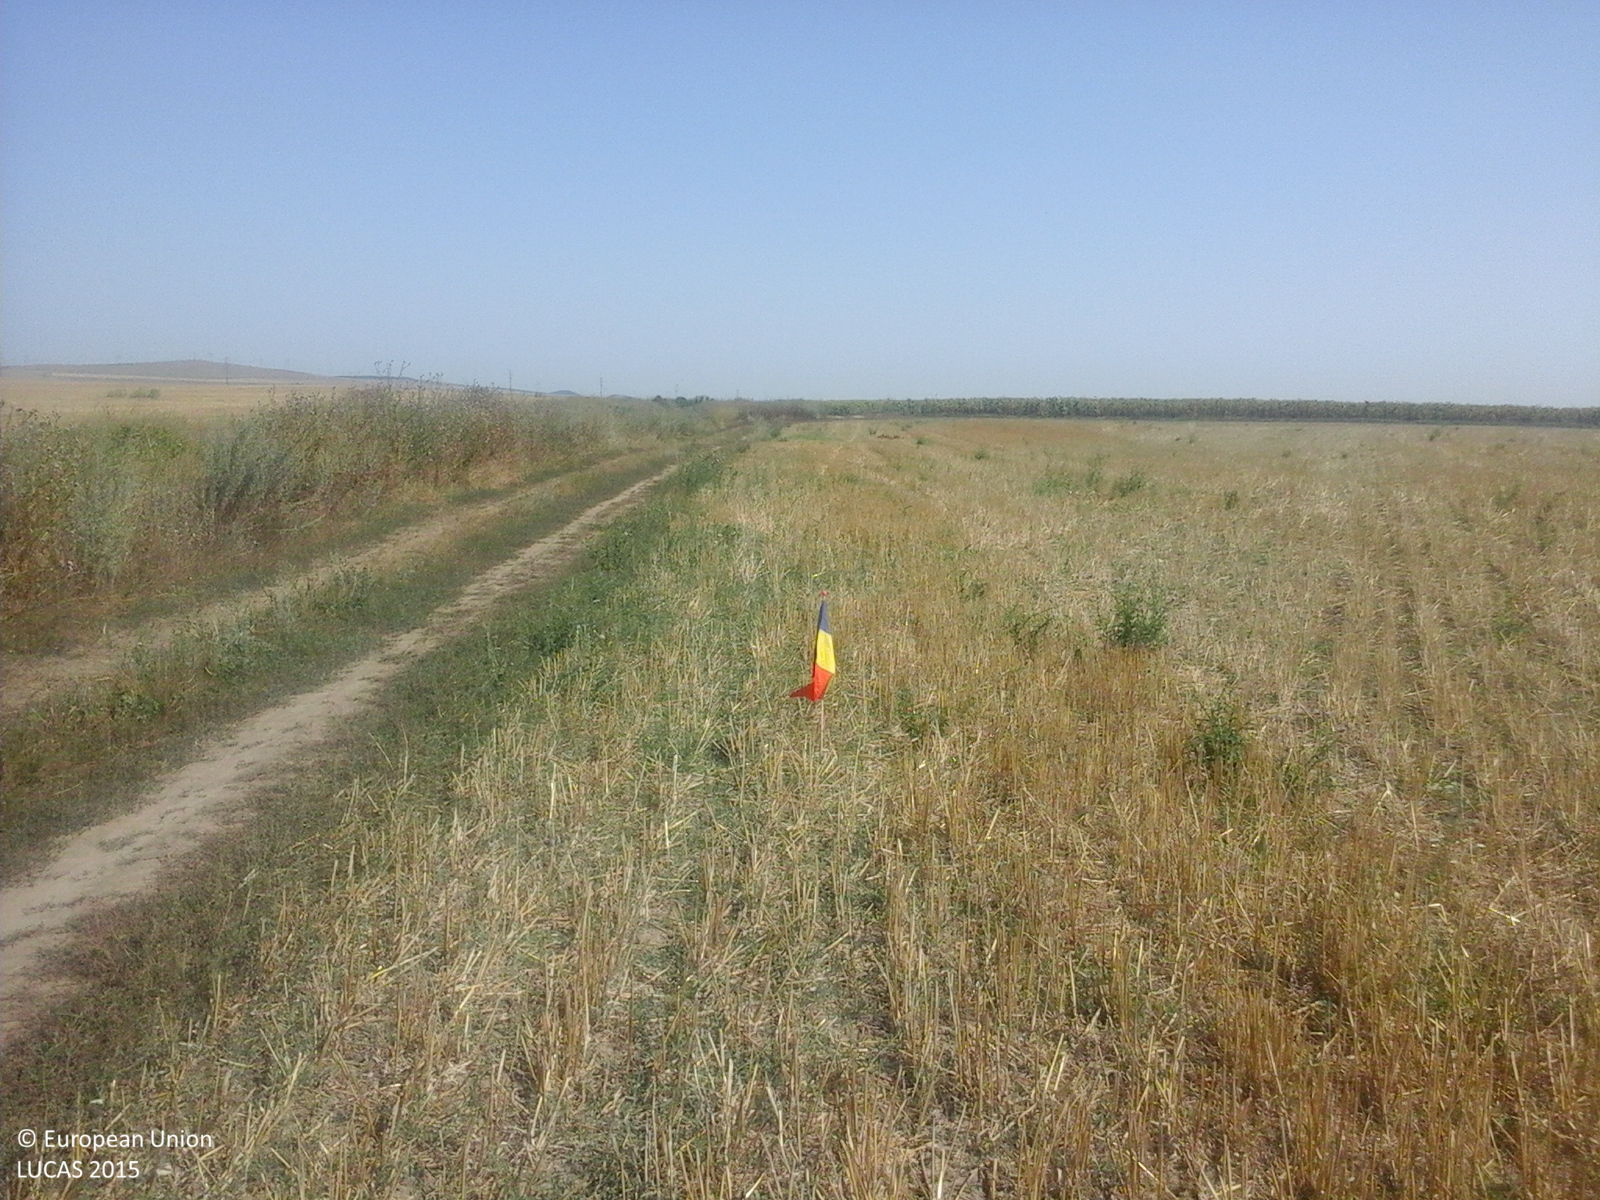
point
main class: Cropland
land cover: Barley
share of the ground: > 75 %
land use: Agriculture (excluding fallow land and kitchen gardens)
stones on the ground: < 10 %
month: August
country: RO
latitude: 44.5636
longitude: 28.1295
